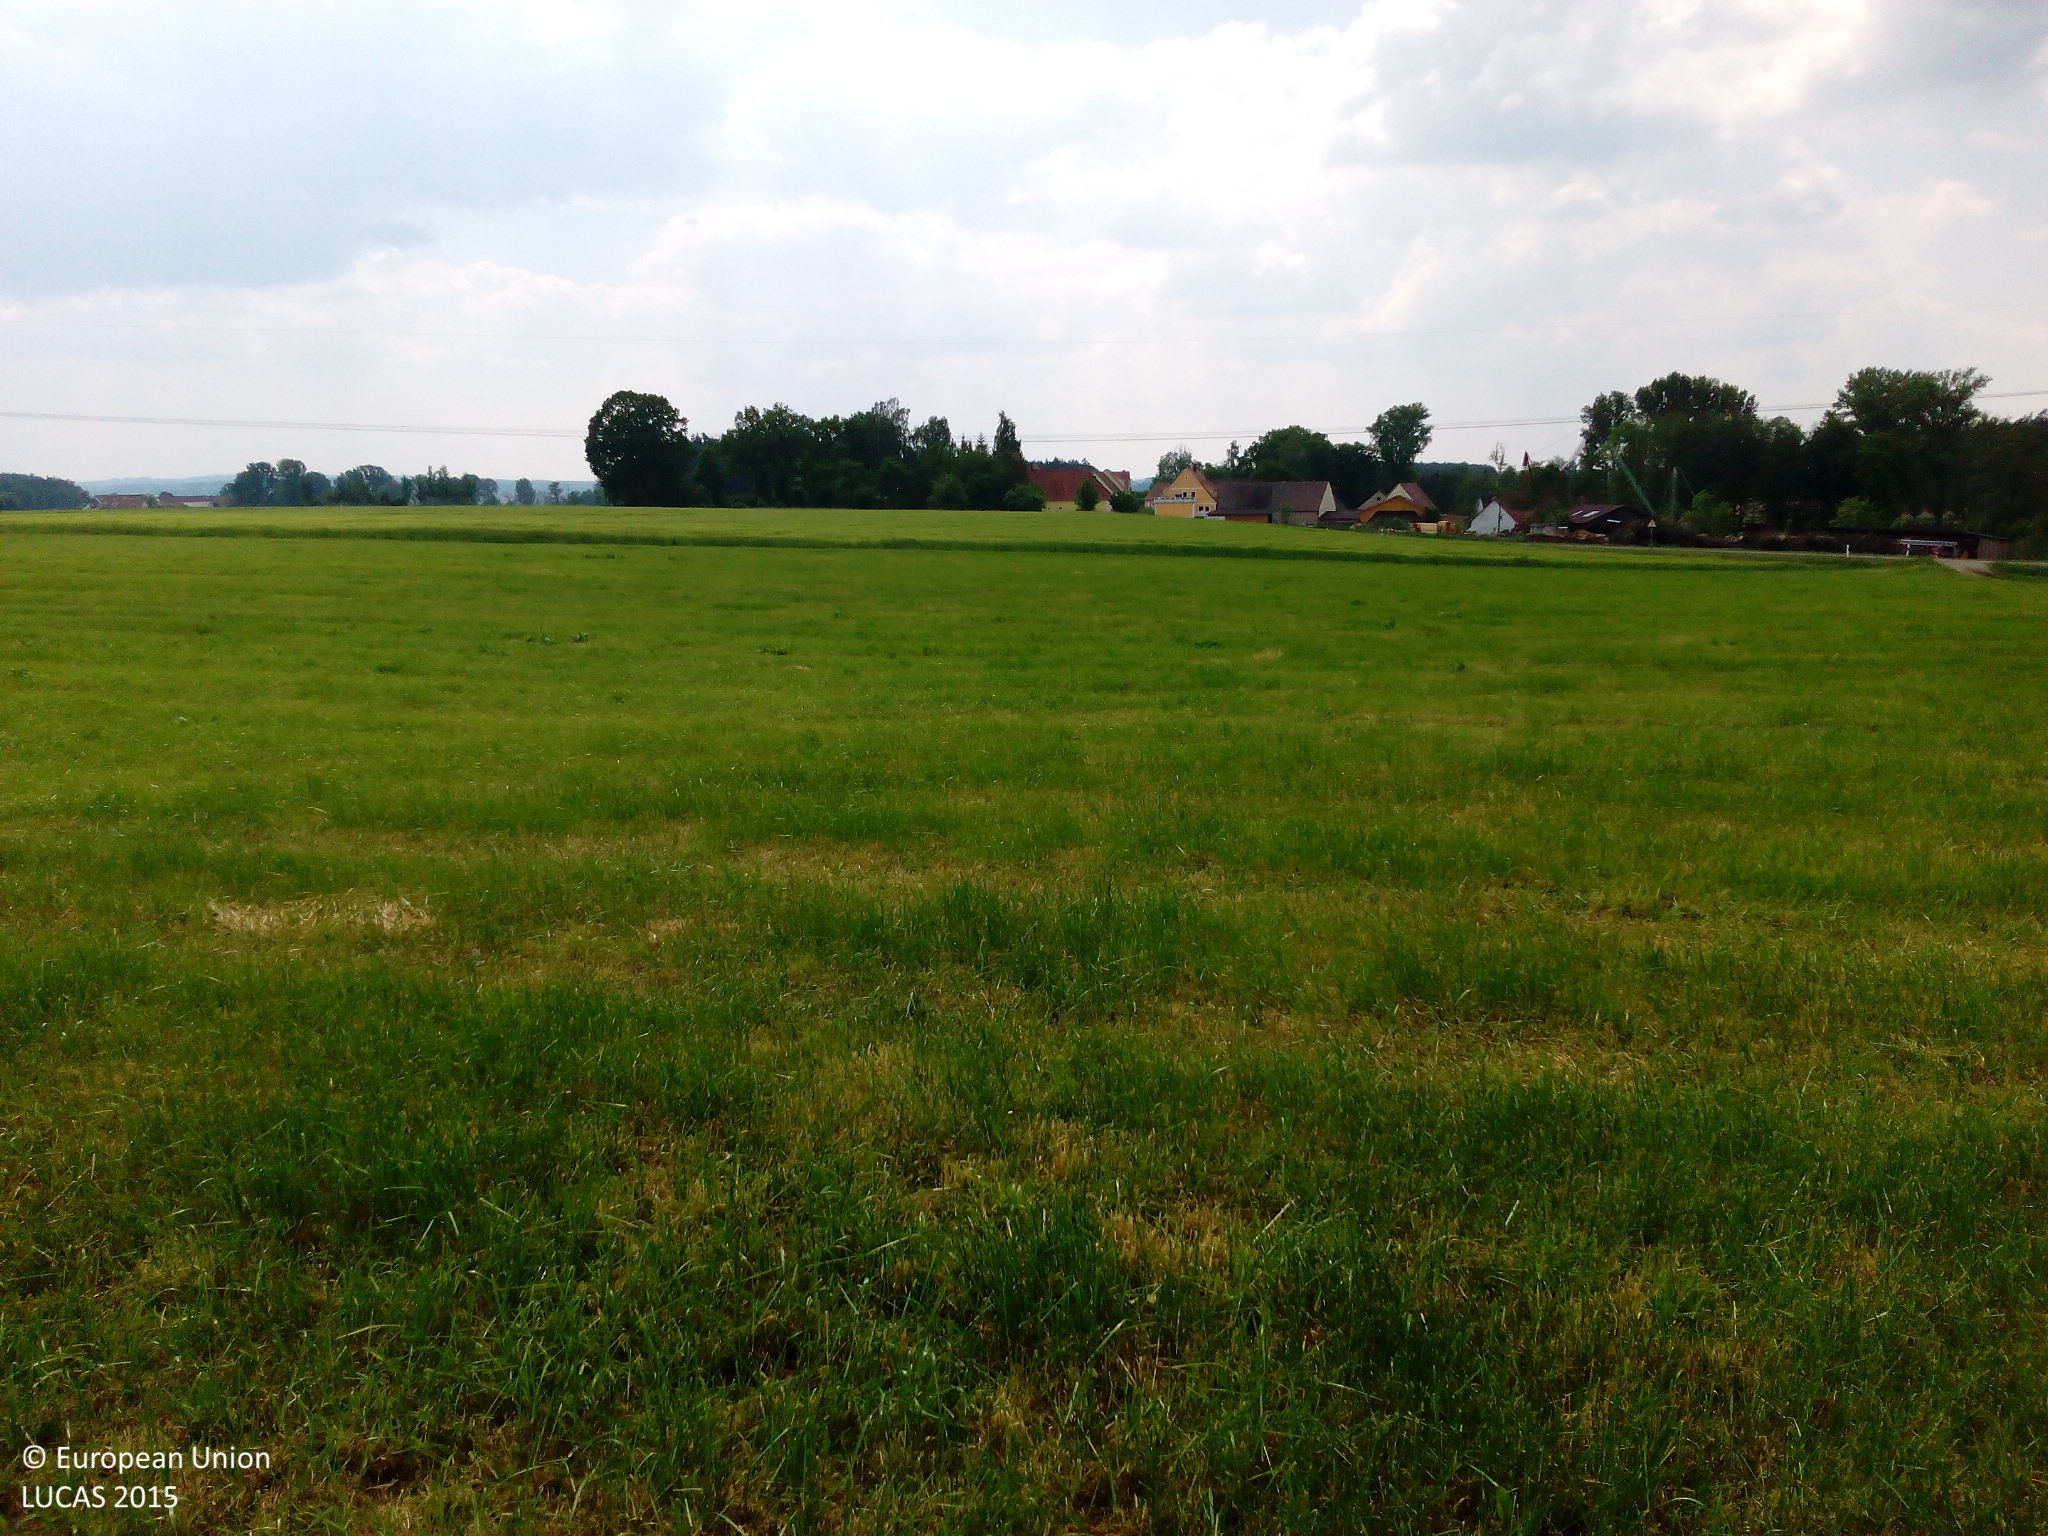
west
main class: Grassland
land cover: Grassland without tree/shrub cover
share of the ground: > 75 %
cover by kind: herbaceous plants 100 %
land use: Agriculture (excluding fallow land and kitchen gardens)
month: May
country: DE
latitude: 49.2114
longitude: 10.6175
